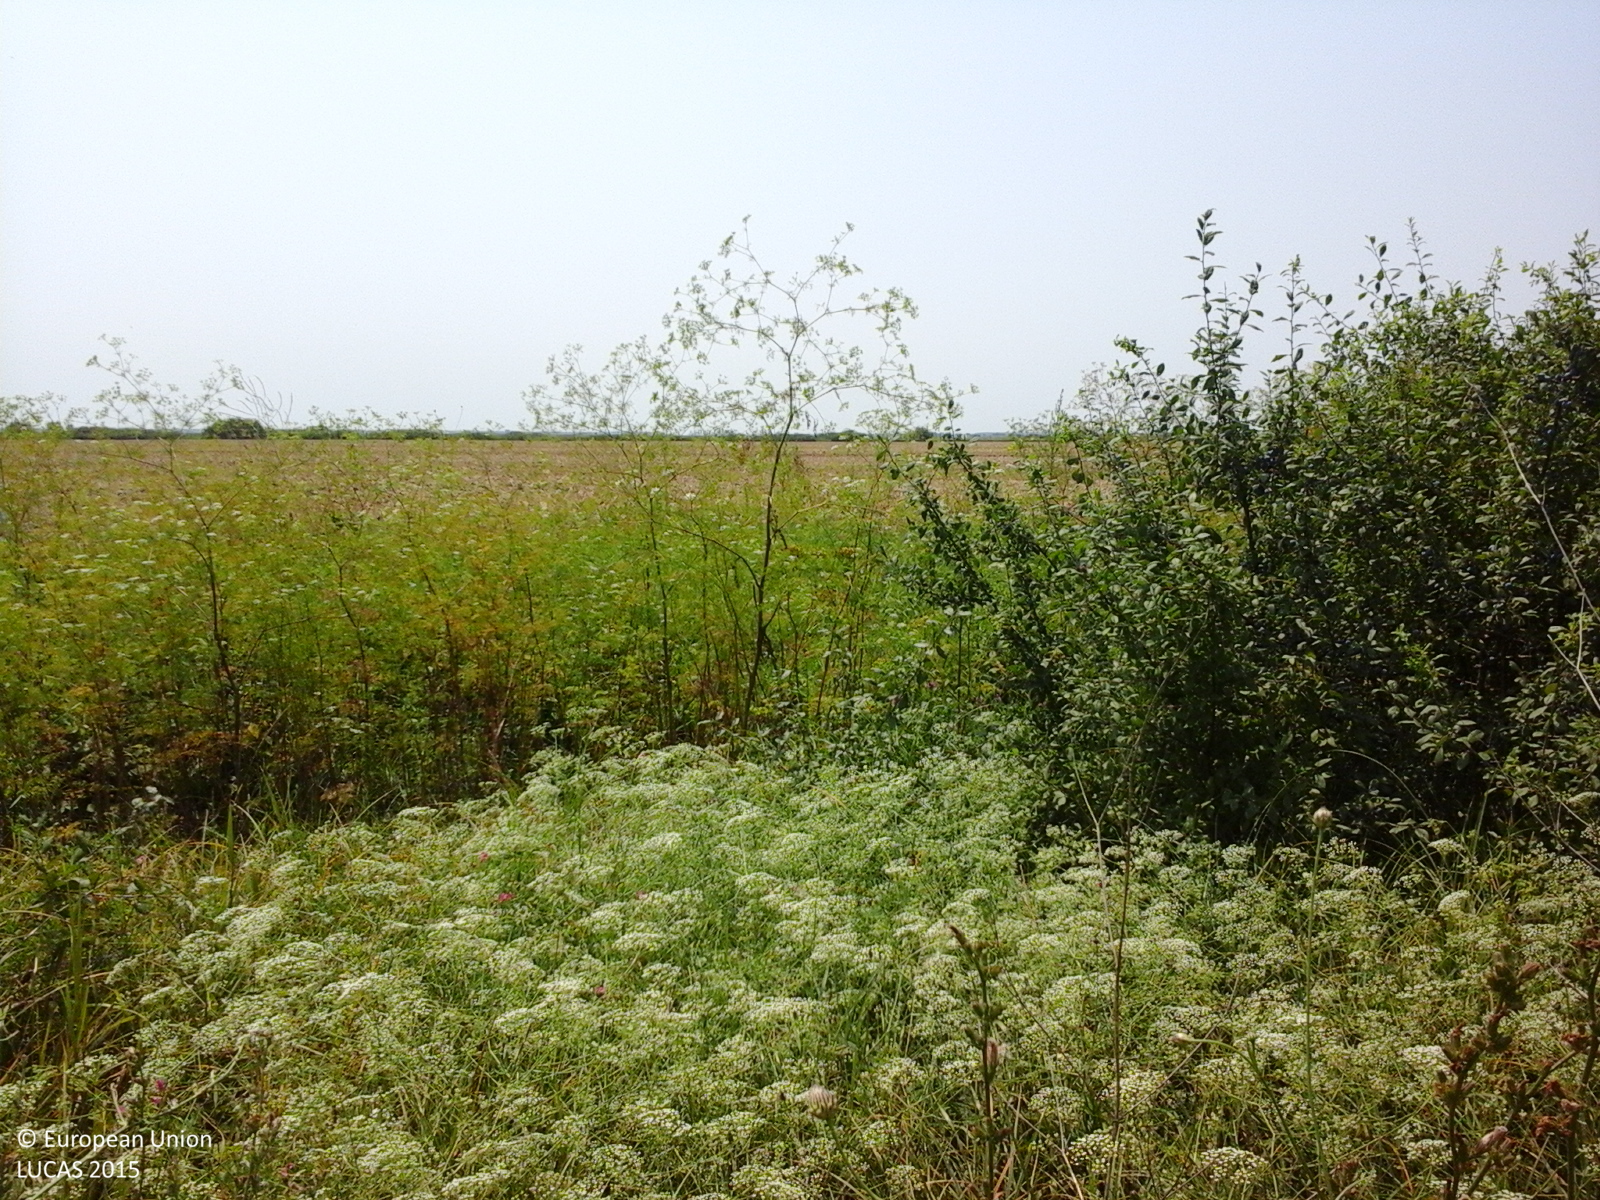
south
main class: Cropland
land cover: Maize
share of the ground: > 75 %
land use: Agriculture (excluding fallow land and kitchen gardens)
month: July
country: RO
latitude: 44.7640
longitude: 26.2717
